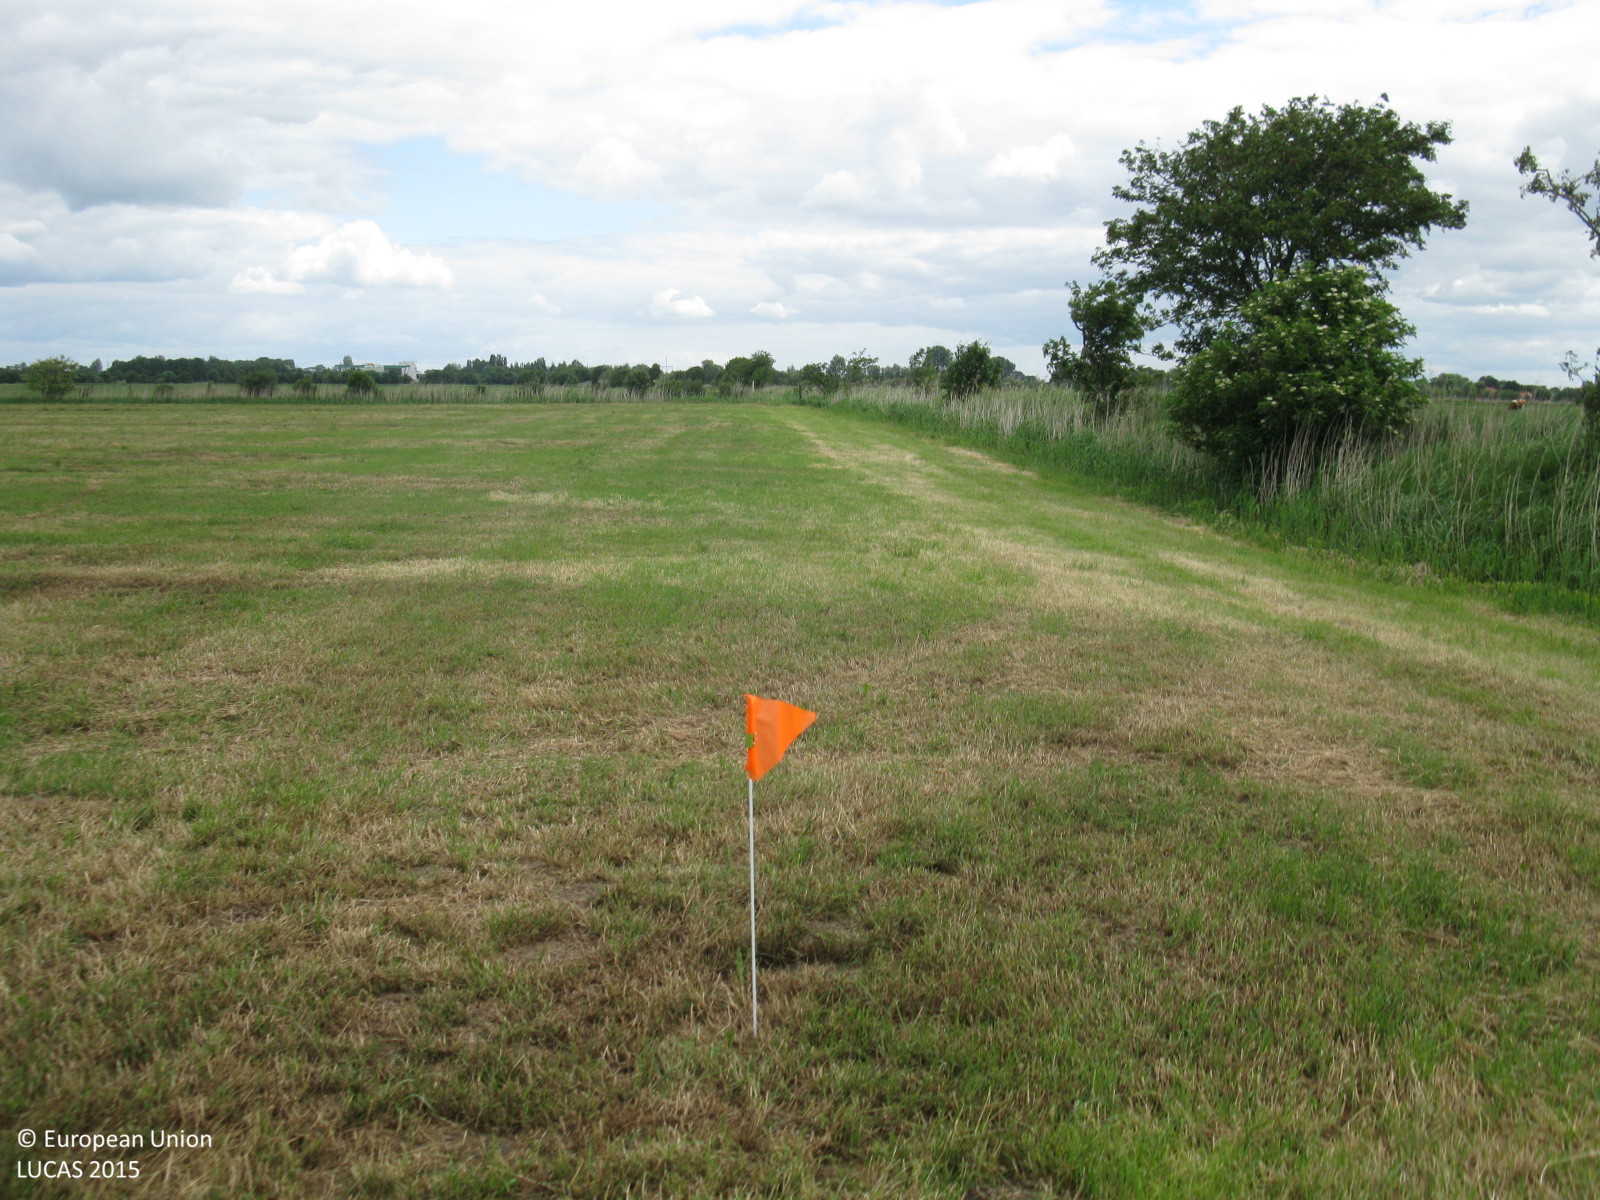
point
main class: Grassland
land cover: Grassland without tree/shrub cover
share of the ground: > 75 %
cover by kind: herbaceous plants 100 %
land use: Agriculture (excluding fallow land and kitchen gardens)
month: June
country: DE
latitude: 53.3022
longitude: 7.4046
